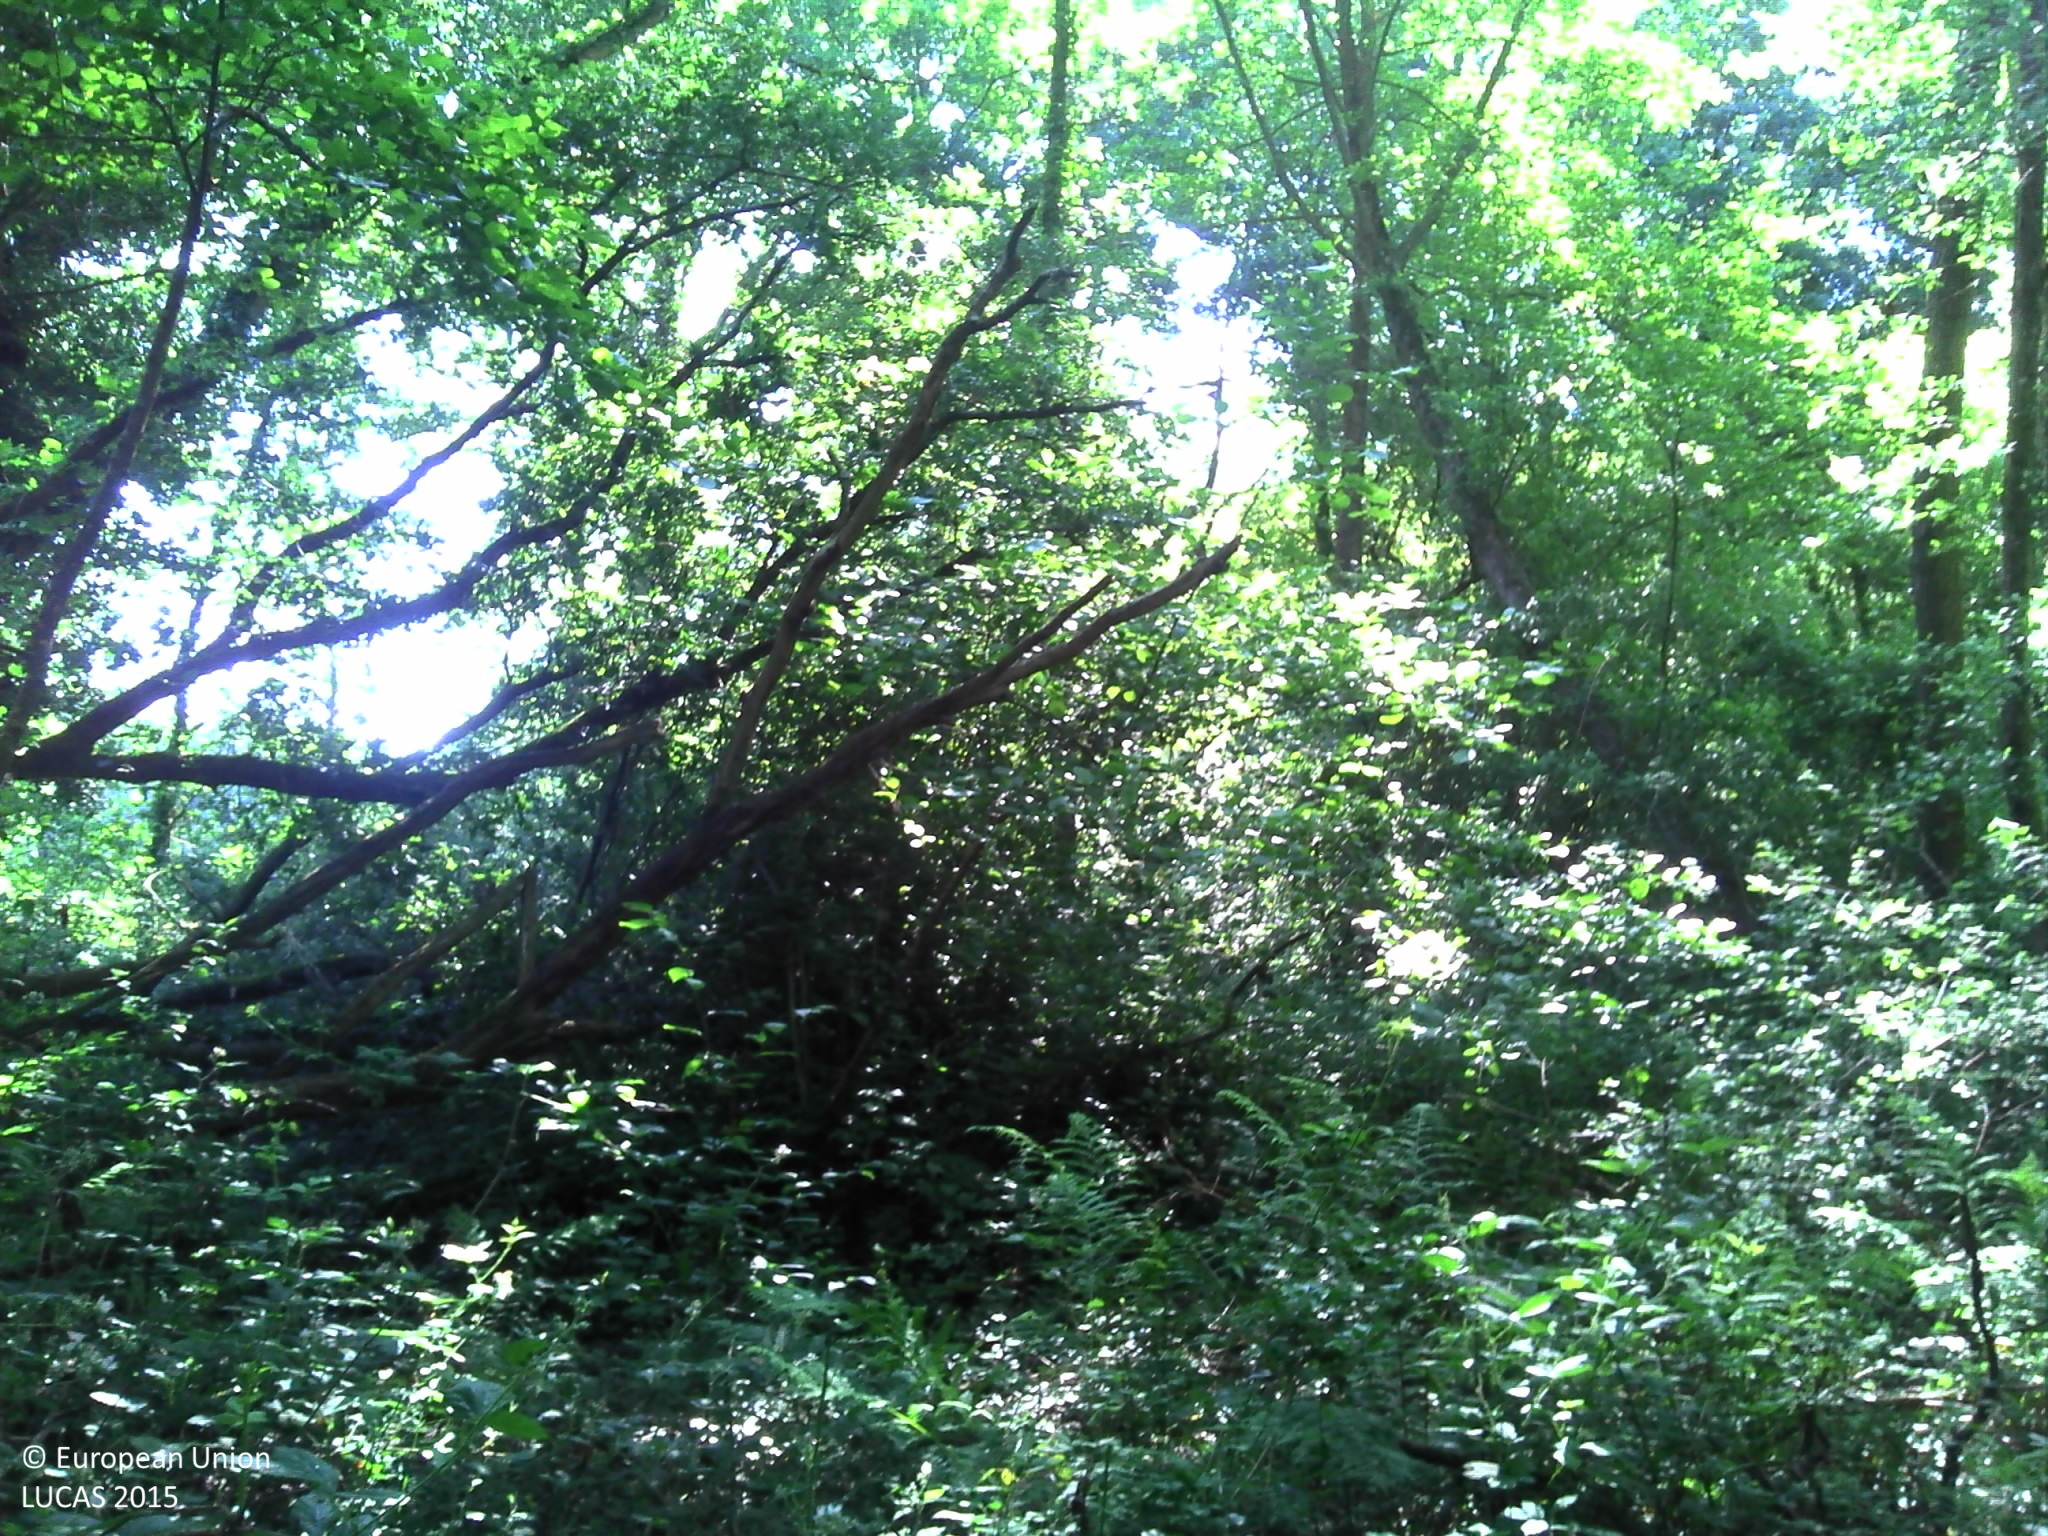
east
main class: Woodland
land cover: Broadleaved woodland
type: acidophilous oak and oak-birch forest
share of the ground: > 75 %
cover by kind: broadleaved forest trees 75 %, herbaceous plants 15 %, shrubs 10 %
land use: Forestry
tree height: > 5 m
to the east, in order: Broadleaved woodland; Managed hedges; Grassland with sparse tree/shrub cover; Fences; Rivers and streams; Broadleaved woodland; Pine dominated mixed woodland; Broadleaved woodland
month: June
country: FR
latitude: 47.9146
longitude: 0.2200
